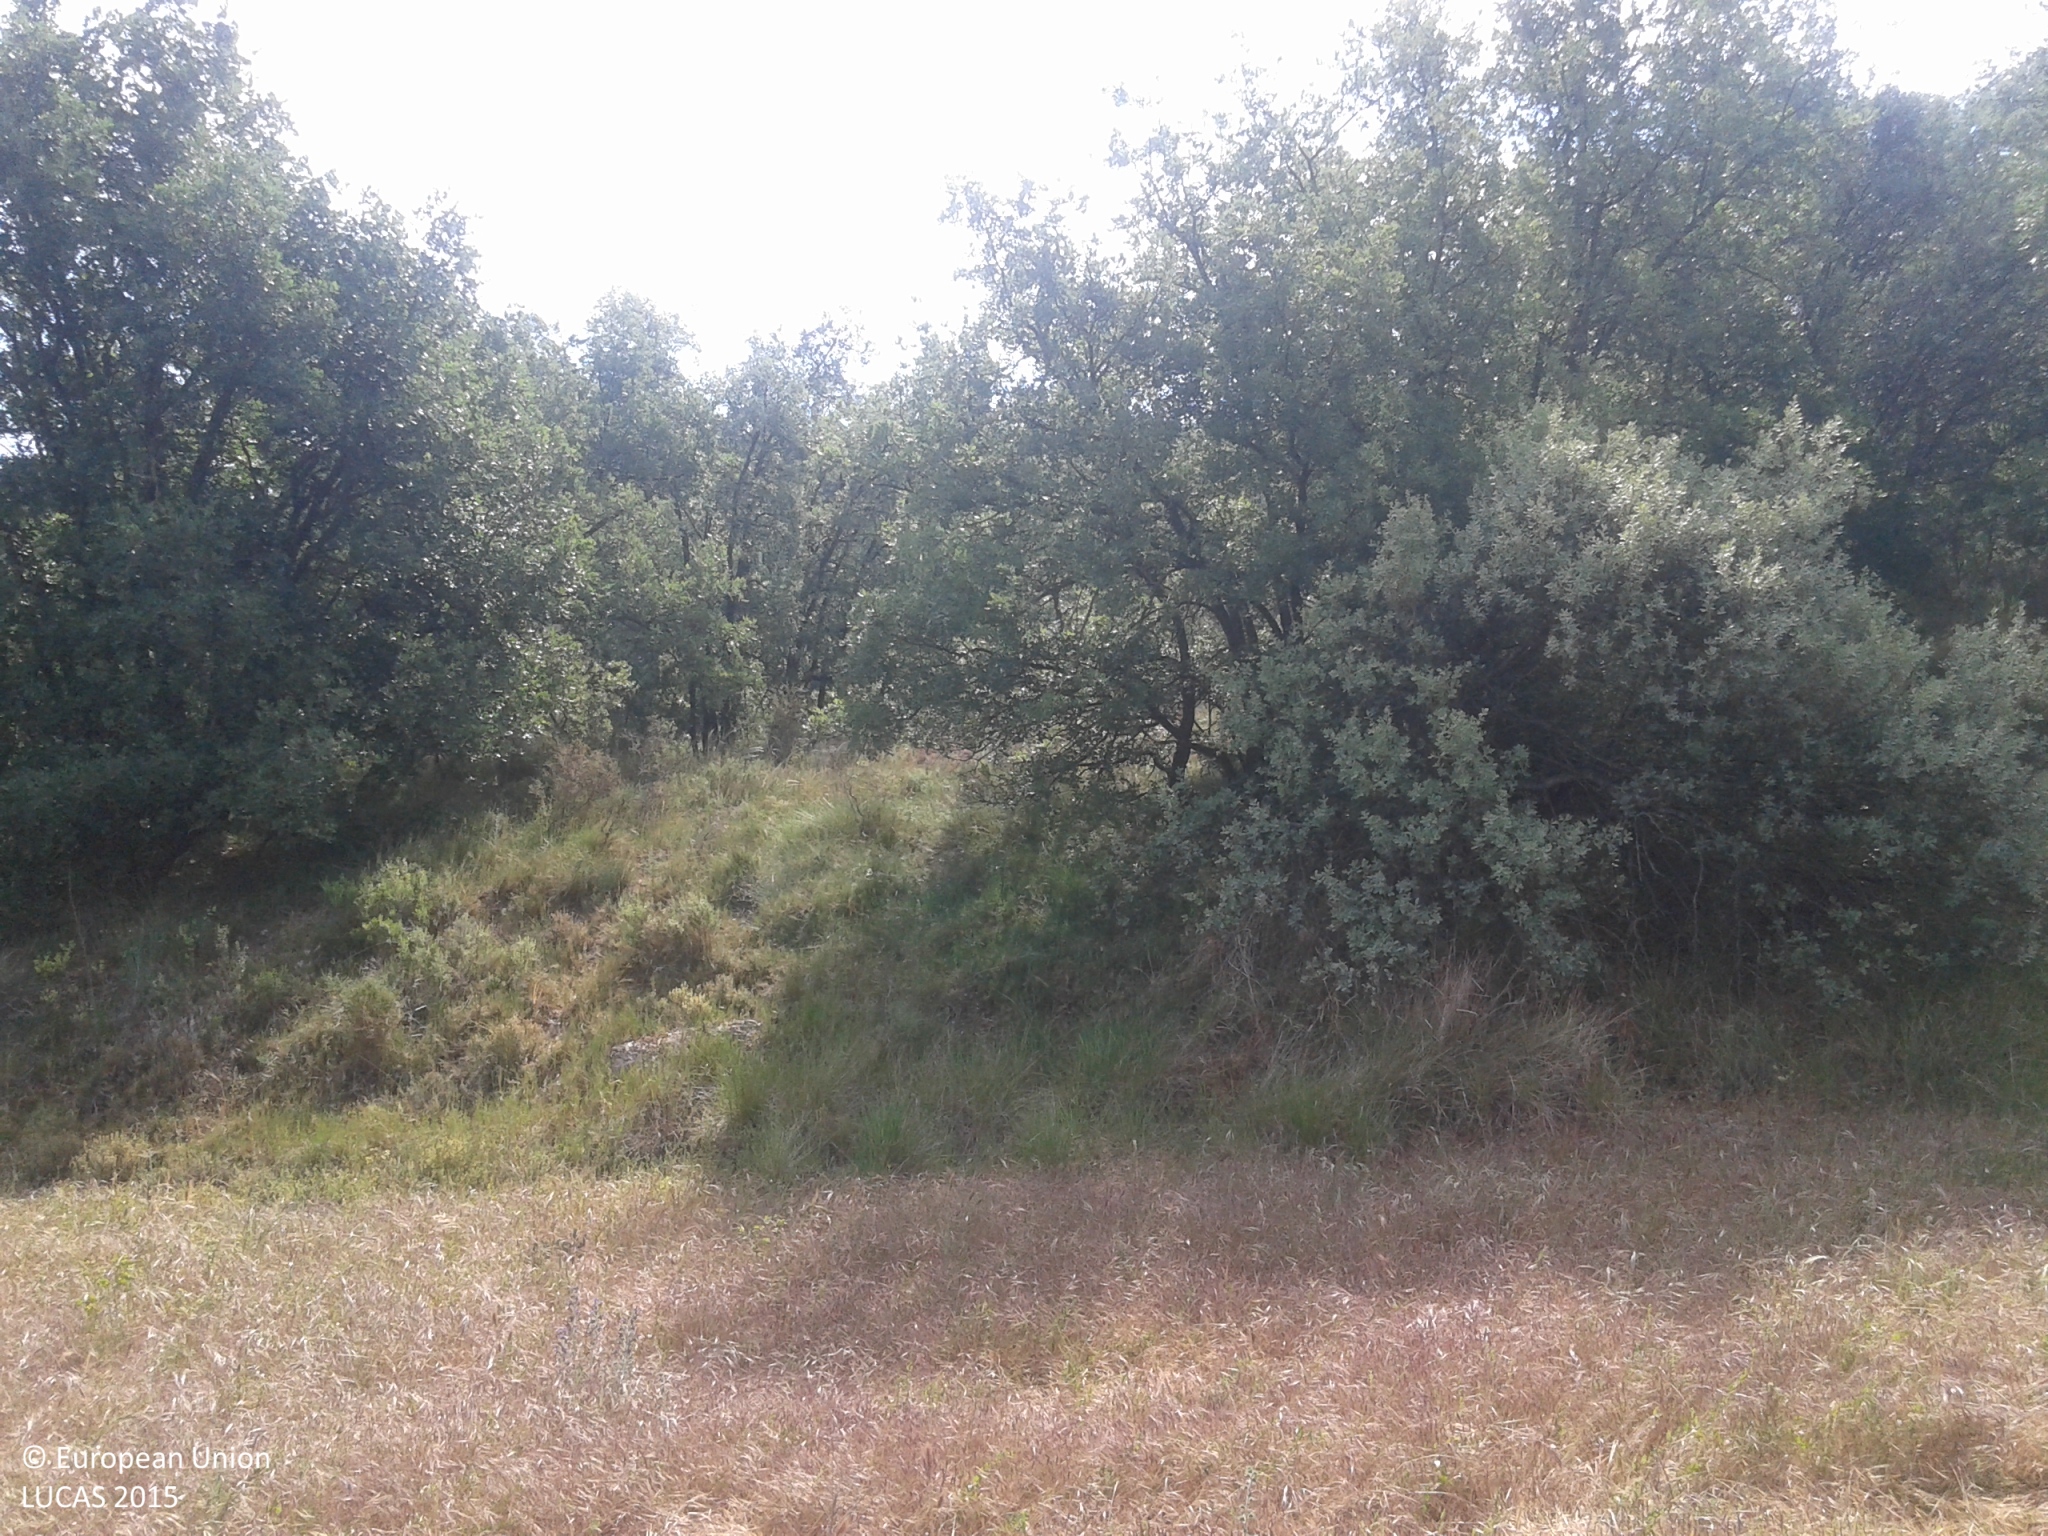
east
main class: Grassland
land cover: Spontaneously vegetated surfaces
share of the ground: > 75 %
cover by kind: herbaceous plants 100 %
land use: Fallow land
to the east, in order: Spontaneously vegetated surfaces; Broadleaved woodland; Spontaneously vegetated surfaces; Broadleaved woodland
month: May
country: ES
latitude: 41.8670
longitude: 1.1570
